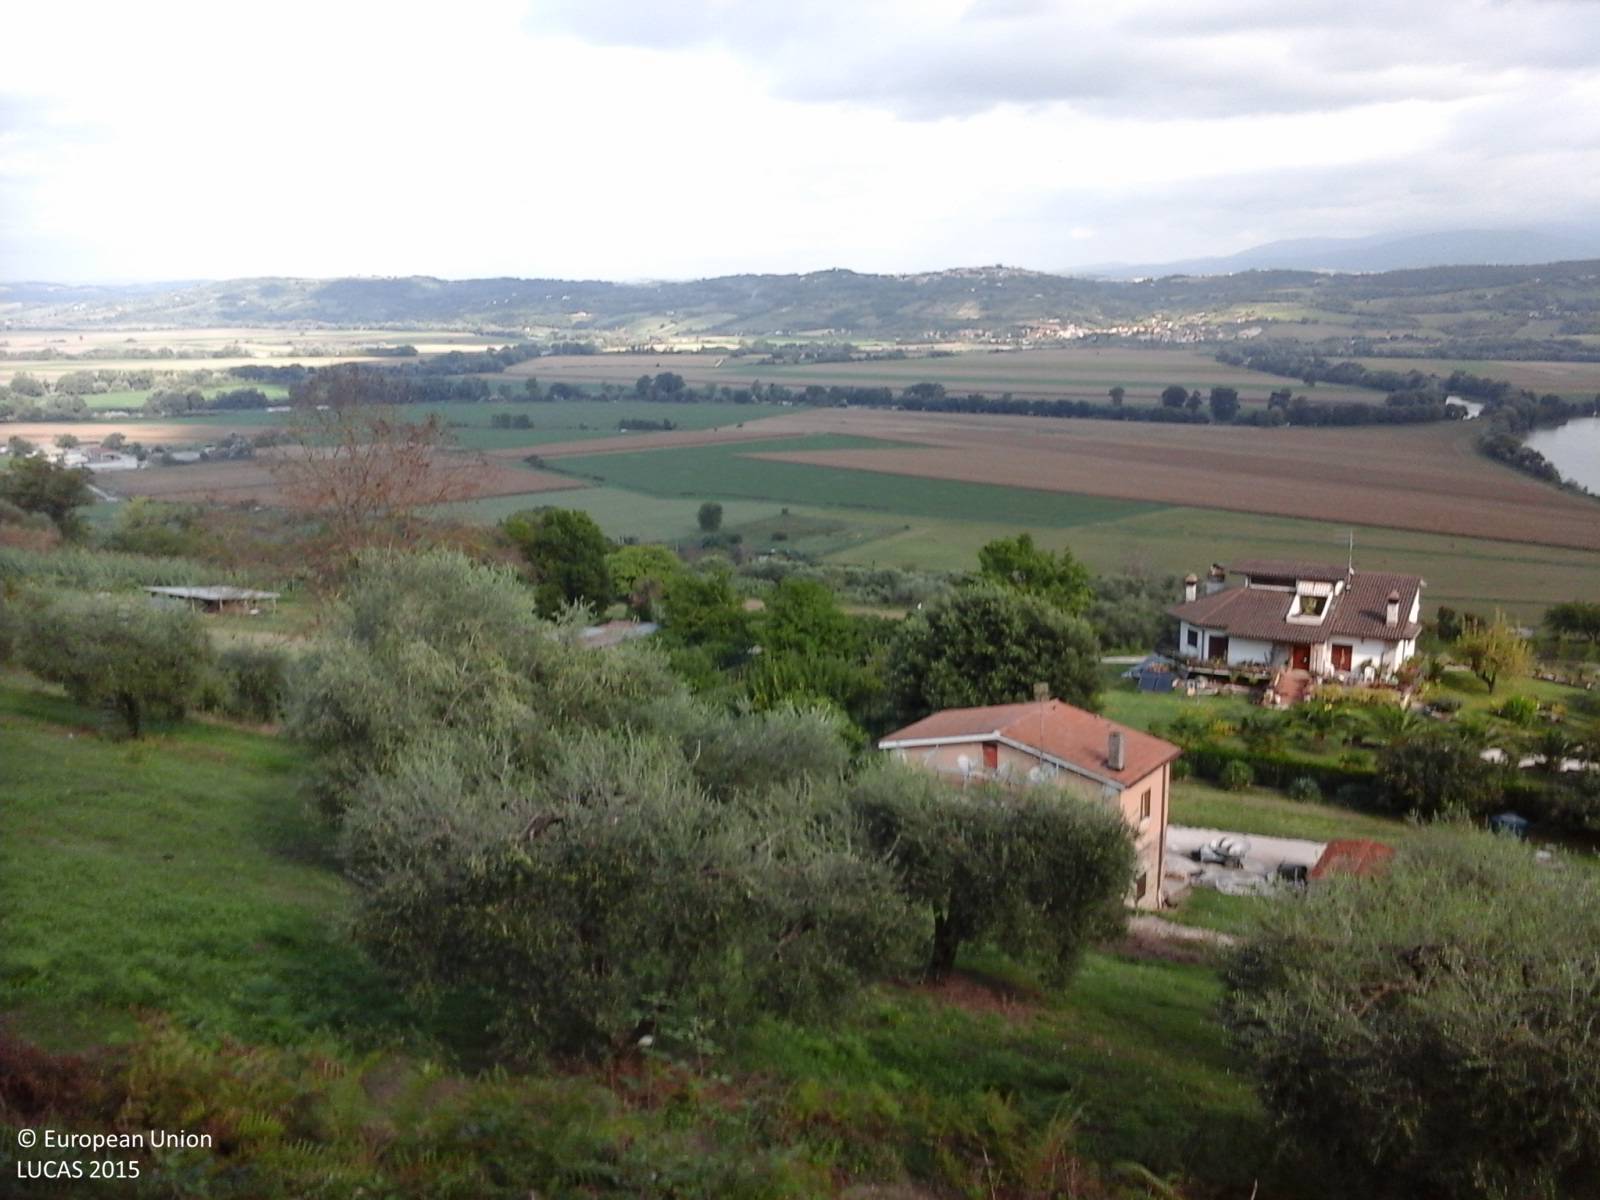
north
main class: Cropland
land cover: Olive groves
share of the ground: 50 - 75 %
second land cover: Spontaneously vegetated surfaces
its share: > 75 %
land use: Kitchen garden
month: September
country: IT
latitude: 42.2599
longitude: 12.5732
